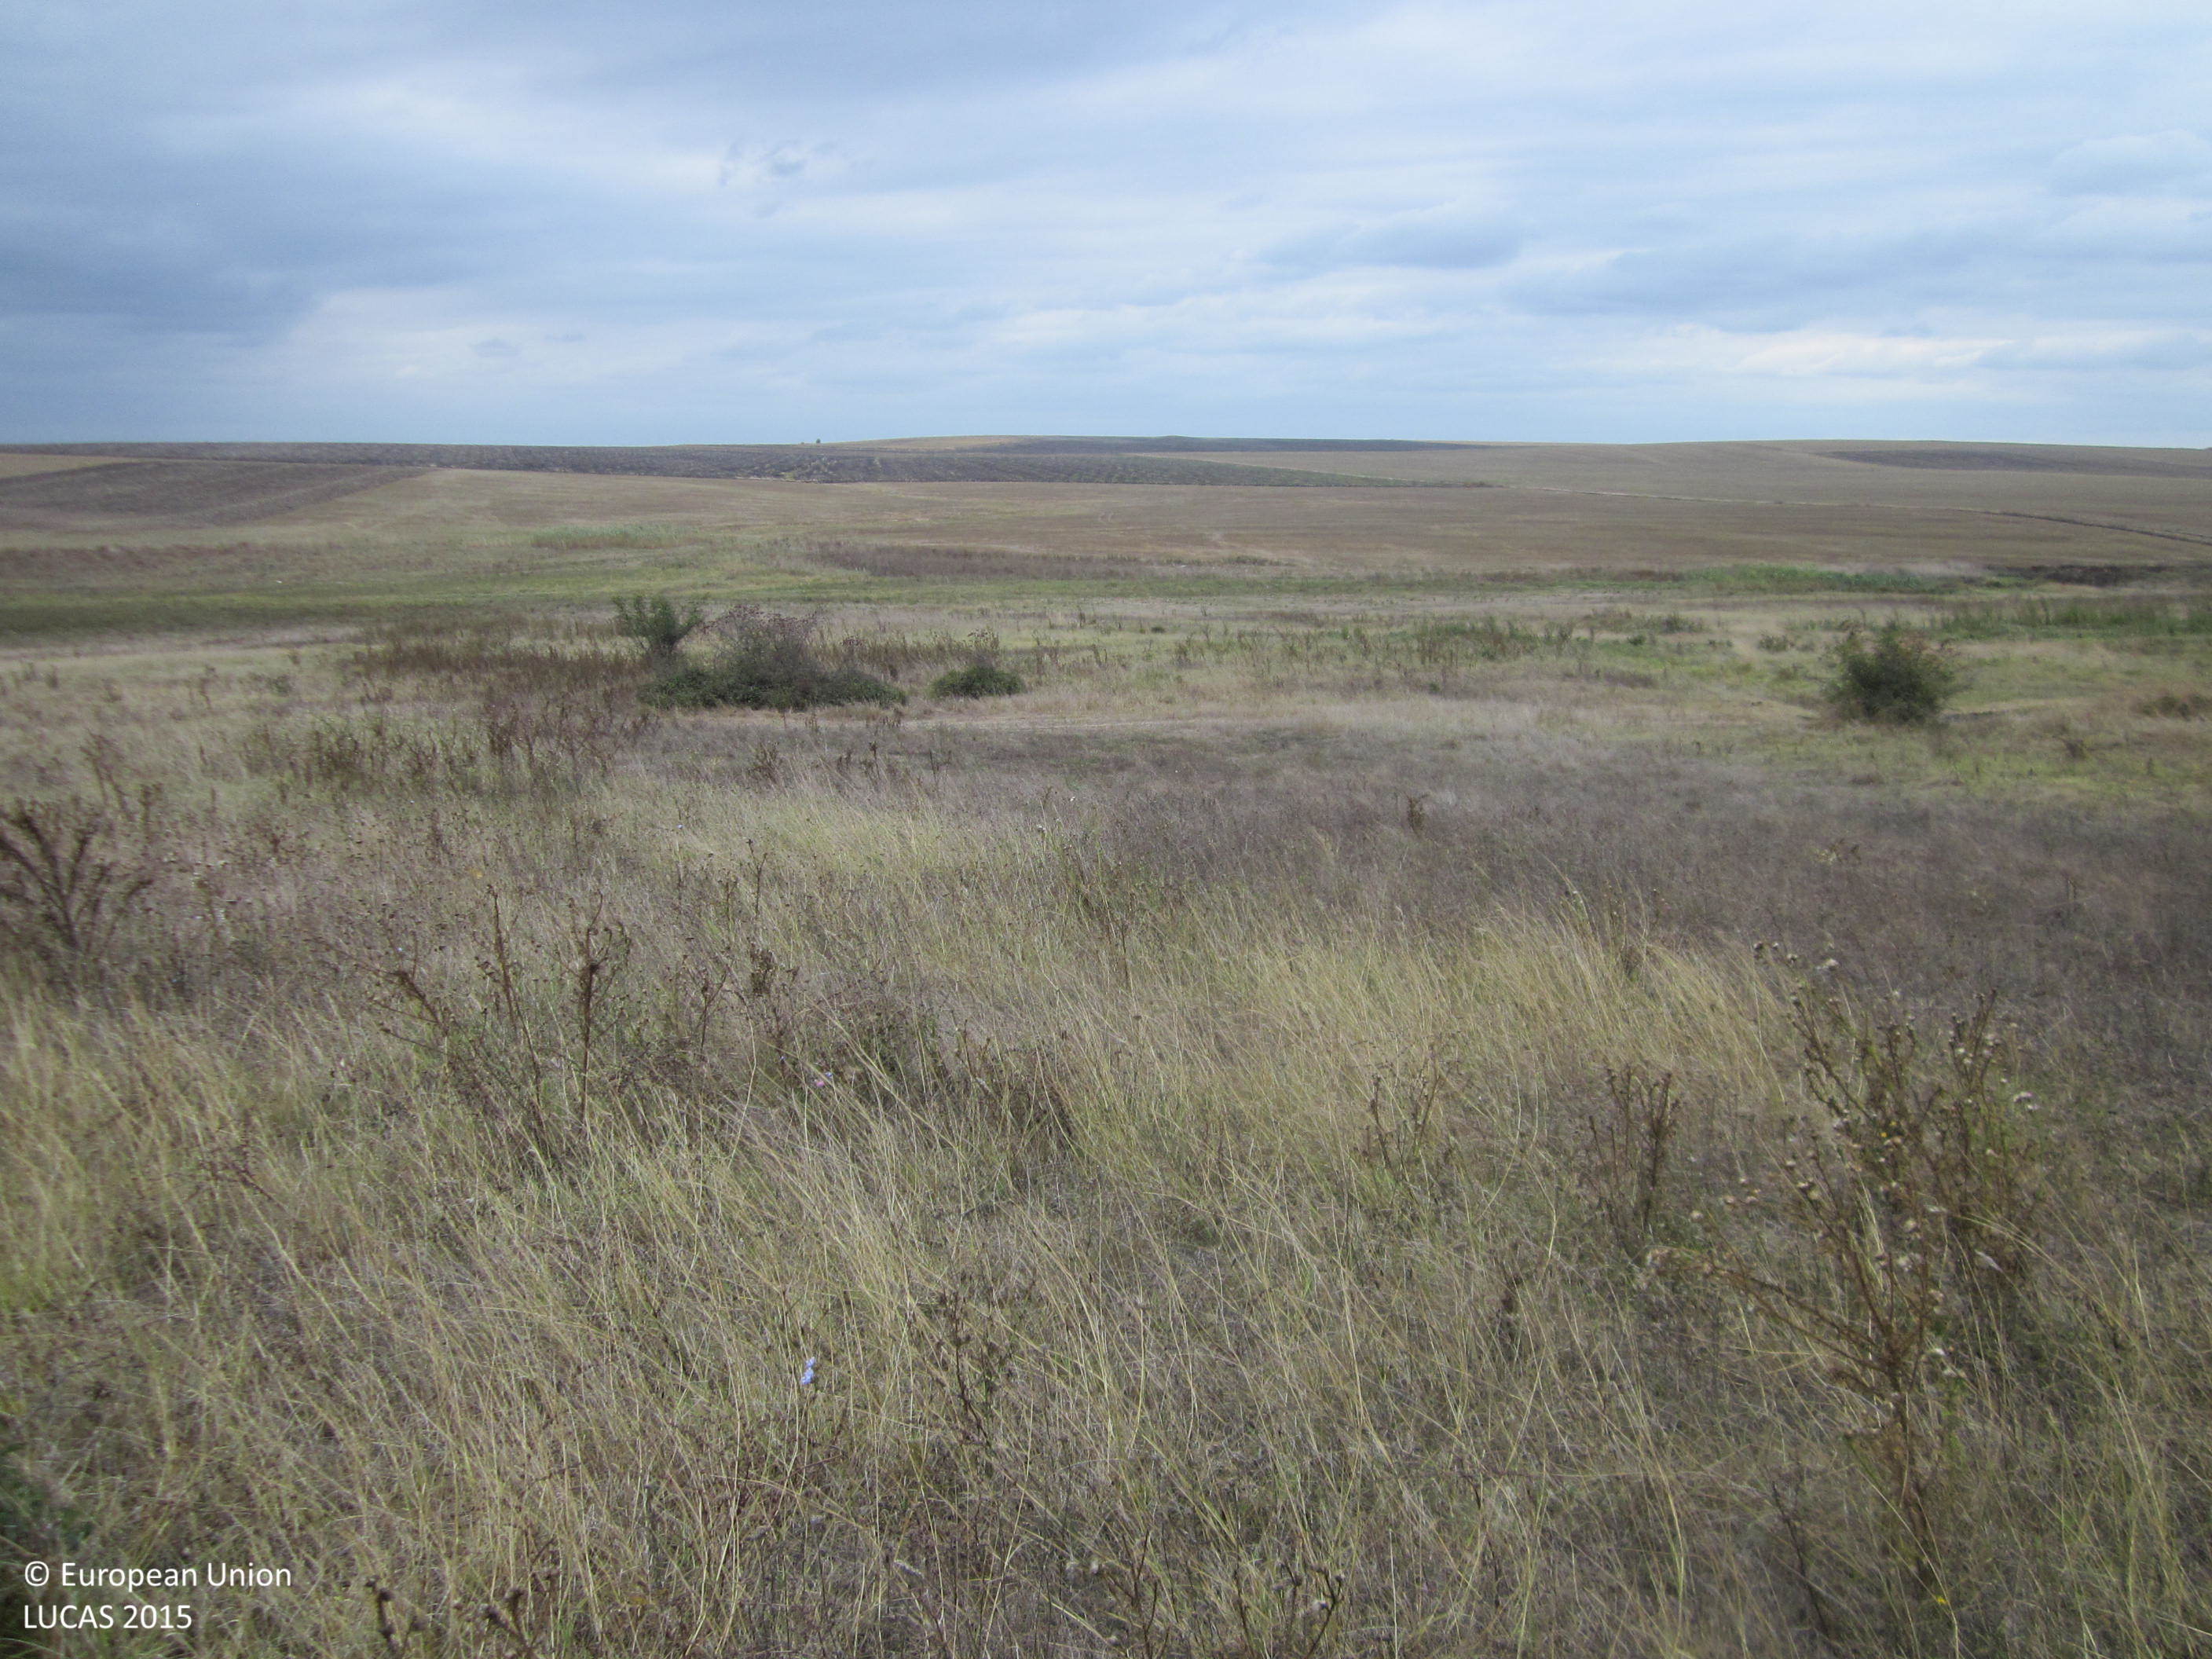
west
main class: Grassland
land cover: Grassland without tree/shrub cover
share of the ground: > 75 %
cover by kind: herbaceous plants 100 %
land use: Agriculture (excluding fallow land and kitchen gardens)
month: September
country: BG
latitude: 42.4569
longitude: 27.3190
